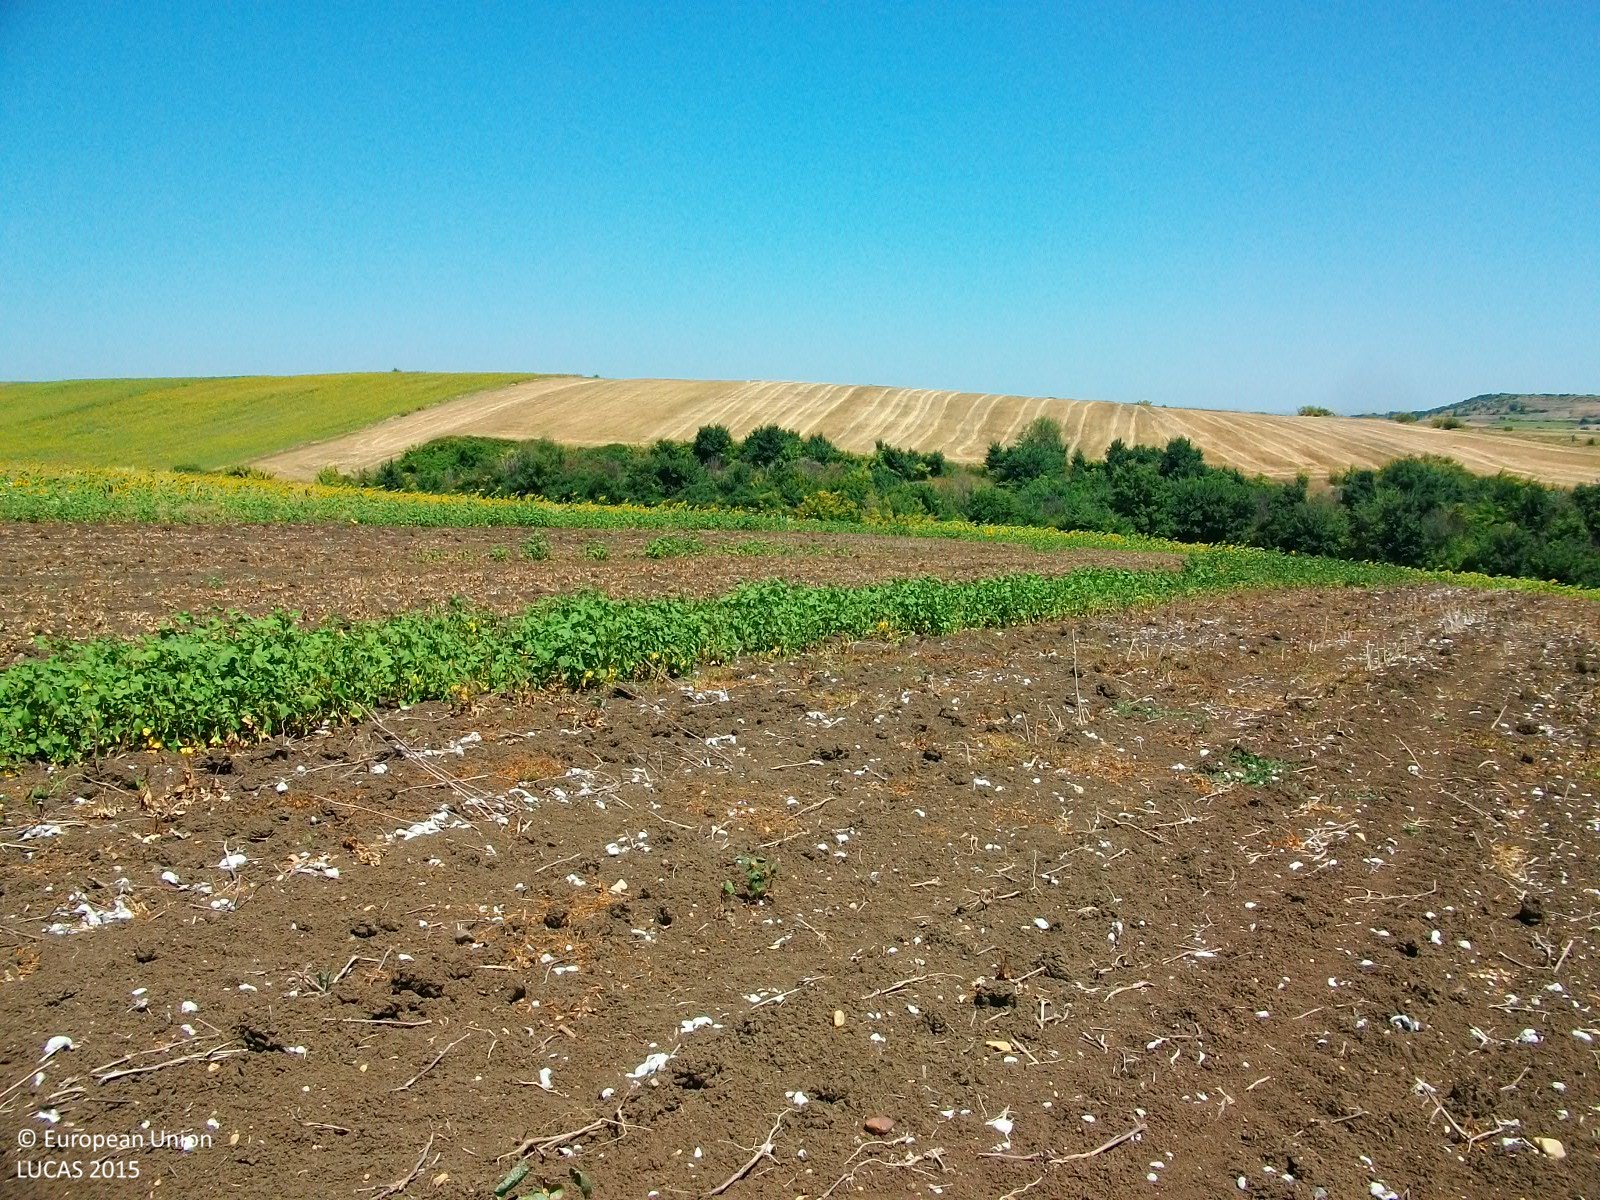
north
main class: Cropland
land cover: Cotton
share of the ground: > 75 %
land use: Agriculture (excluding fallow land and kitchen gardens)
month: July
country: GR
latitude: 41.5487
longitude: 26.2707
